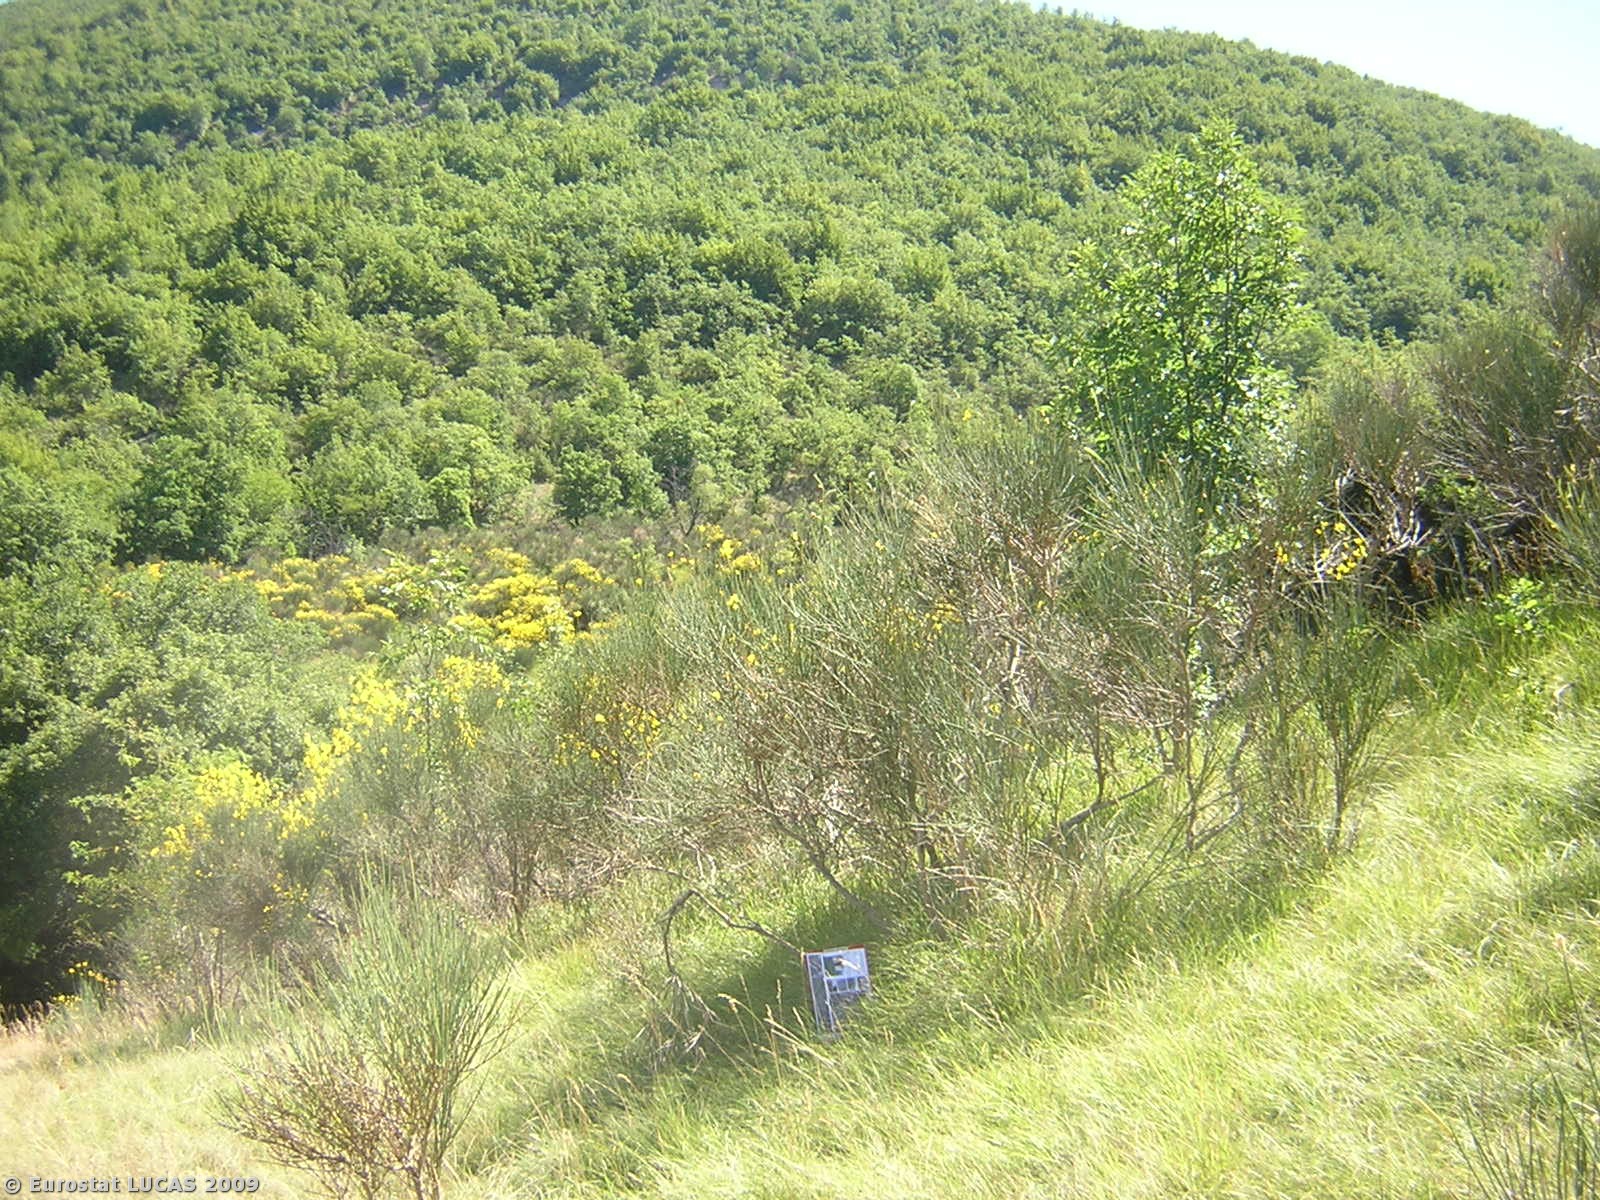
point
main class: Shrubland
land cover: Shrubland with sparse tree cover
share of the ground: > 75 %
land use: Unused
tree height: > 5 m
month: July
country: IT
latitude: 43.1551
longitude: 12.8819
